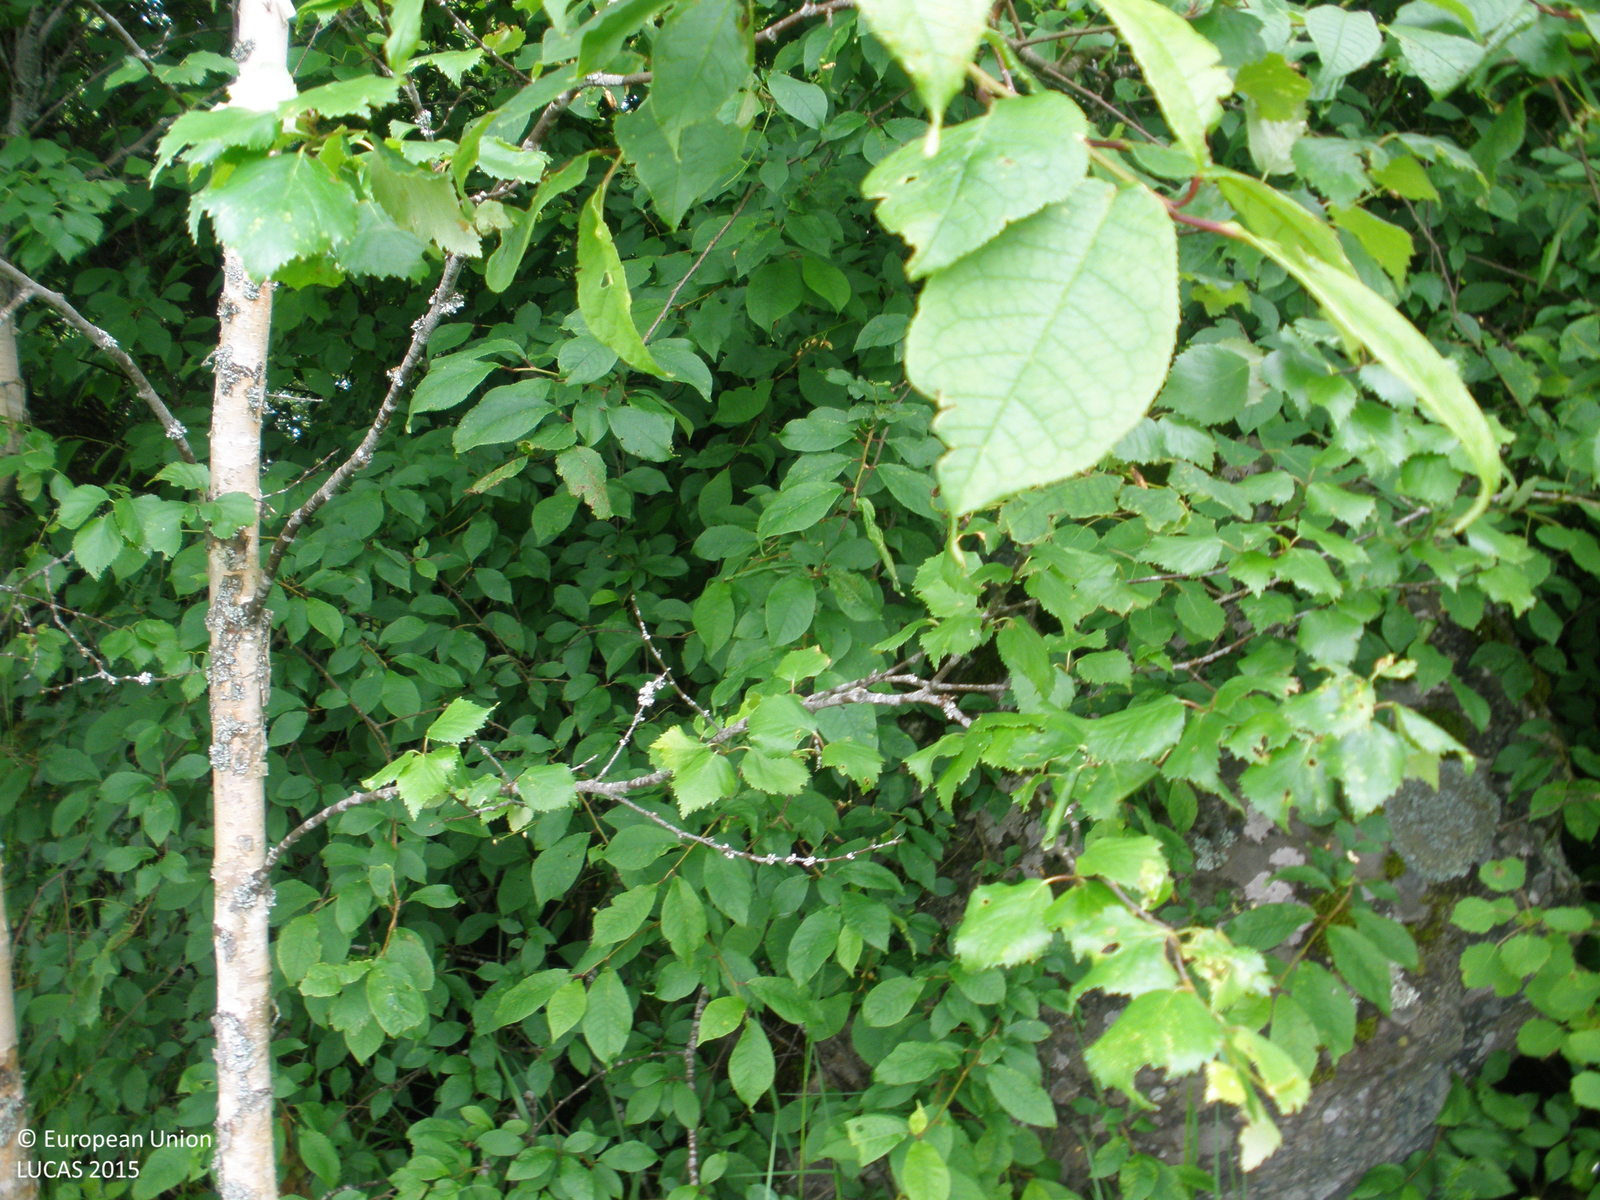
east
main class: Cropland
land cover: Barley
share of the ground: 25 - 50 %
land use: Agriculture (excluding fallow land and kitchen gardens)
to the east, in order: Barley; Ditches and canals; Arable land (only in case pi); Electric lines; Arable land (only in case pi)
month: June
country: FI
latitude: 60.9766
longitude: 23.6671
